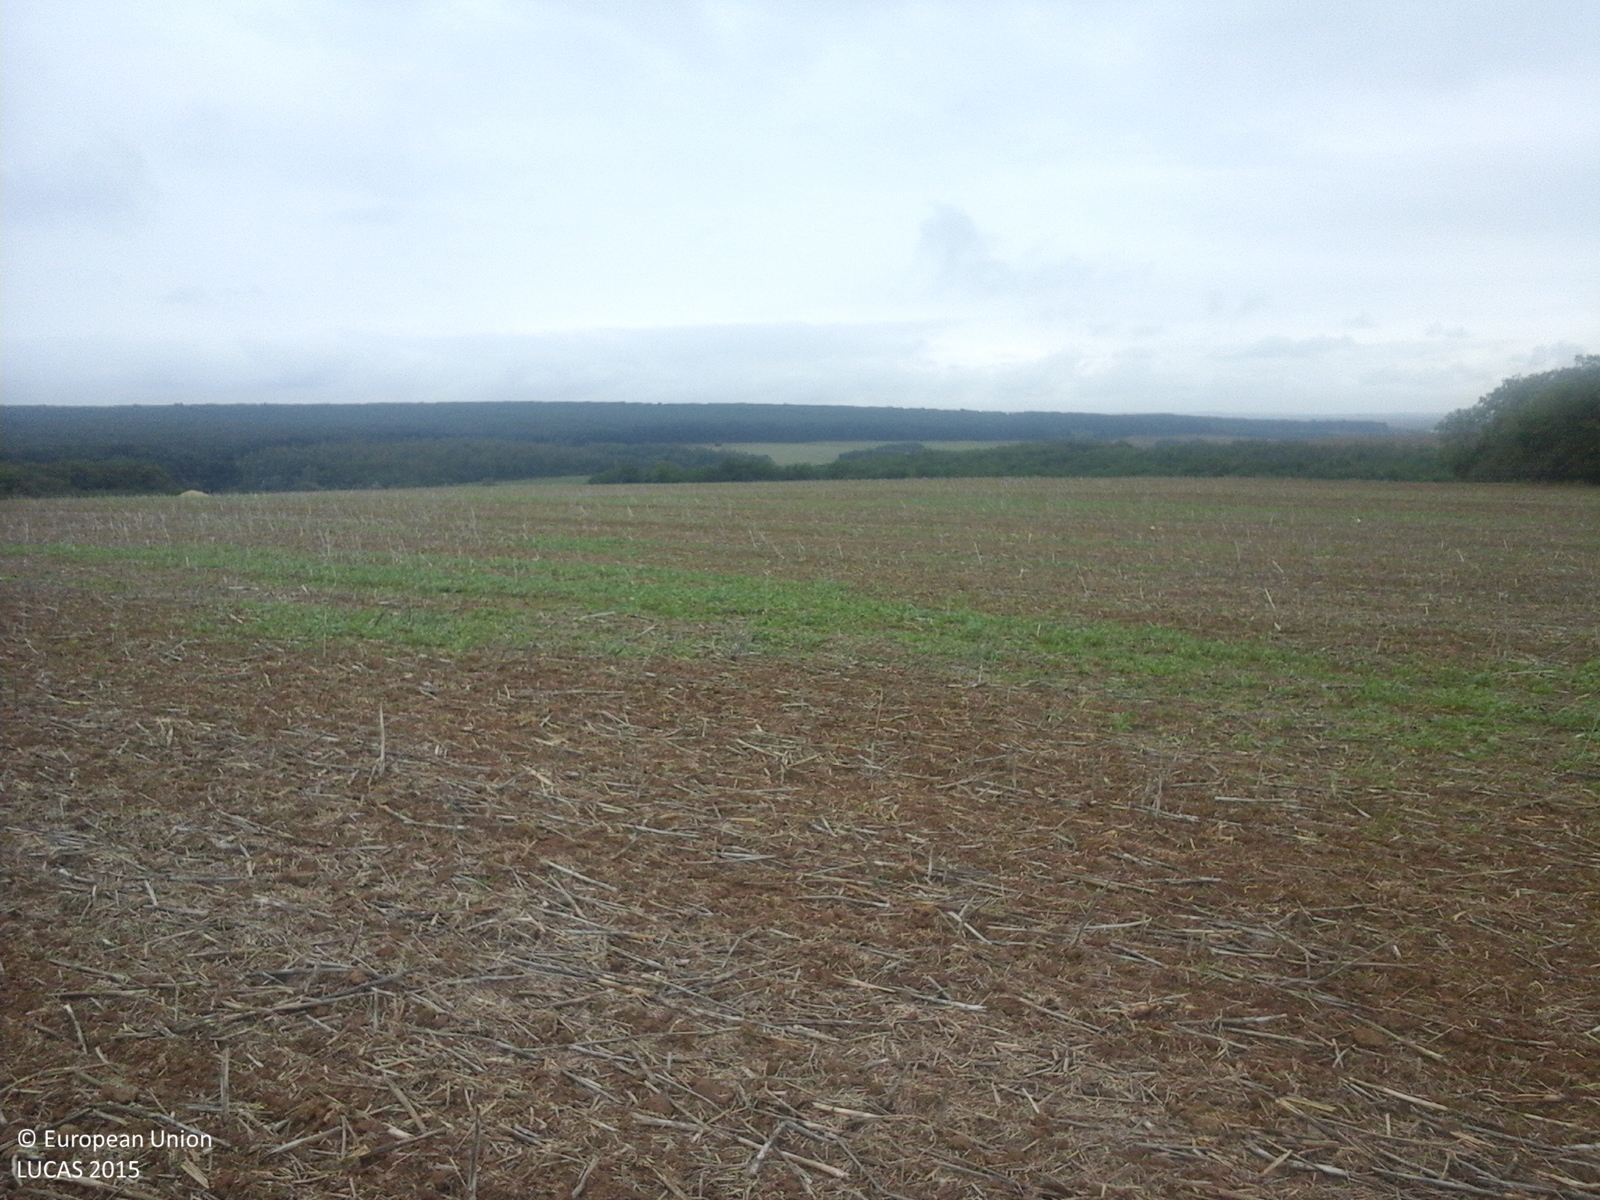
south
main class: Cropland
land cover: Rape and turnip rape
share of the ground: < 10 %
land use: Agriculture (excluding fallow land and kitchen gardens)
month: September
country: RO
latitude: 47.2849
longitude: 22.0677
